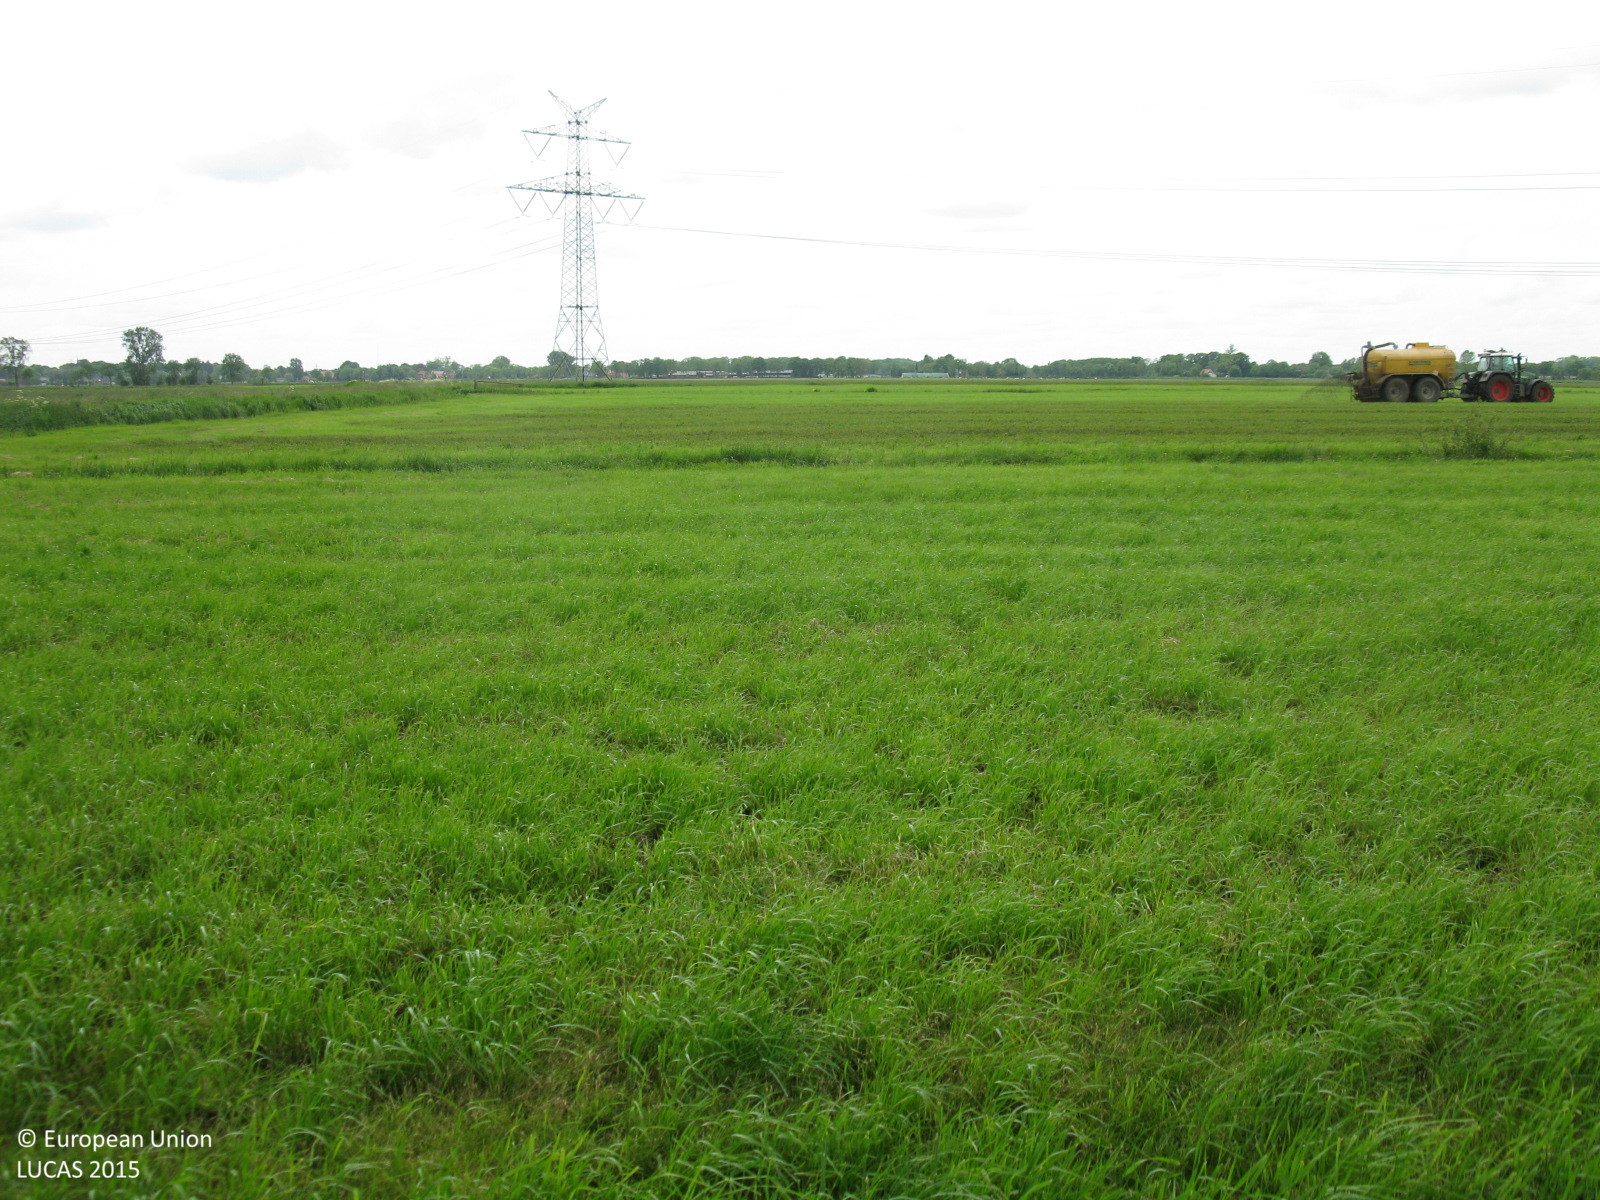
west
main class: Grassland
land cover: Grassland without tree/shrub cover
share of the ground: > 75 %
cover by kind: herbaceous plants 100 %
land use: Agriculture (excluding fallow land and kitchen gardens)
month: June
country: DE
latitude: 53.1393
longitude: 7.3546
